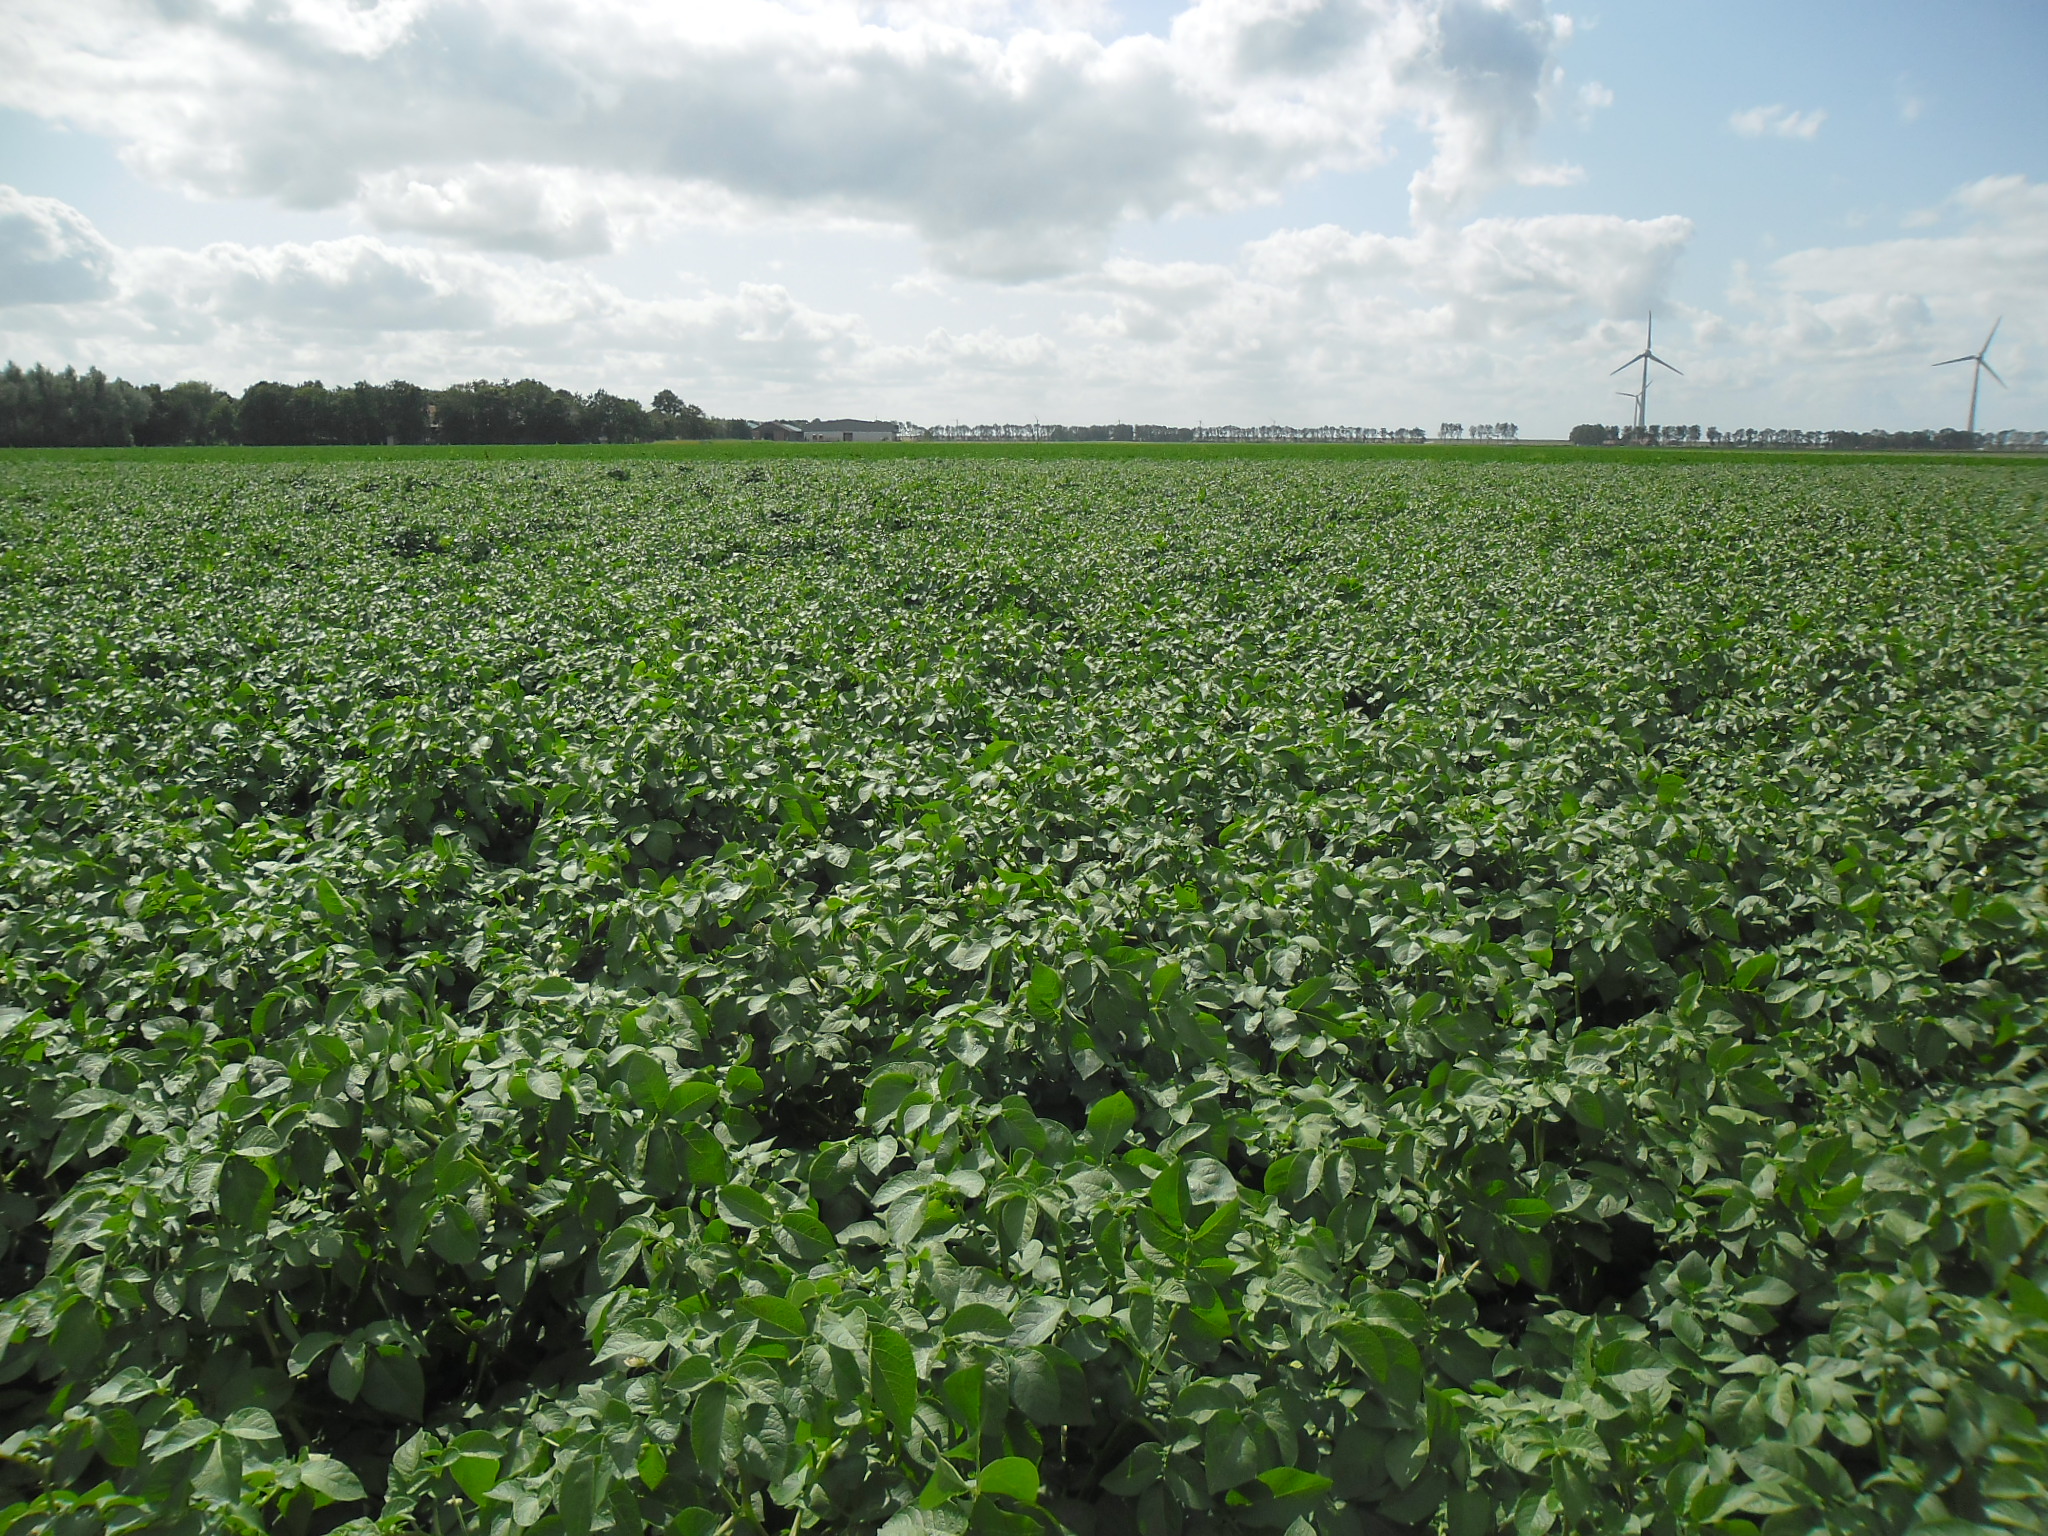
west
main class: Cropland
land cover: Potatoes
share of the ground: > 75 %
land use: Agriculture (excluding fallow land and kitchen gardens)
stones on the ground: < 10 %
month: July
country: NL
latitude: 52.7112
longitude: 5.6322
